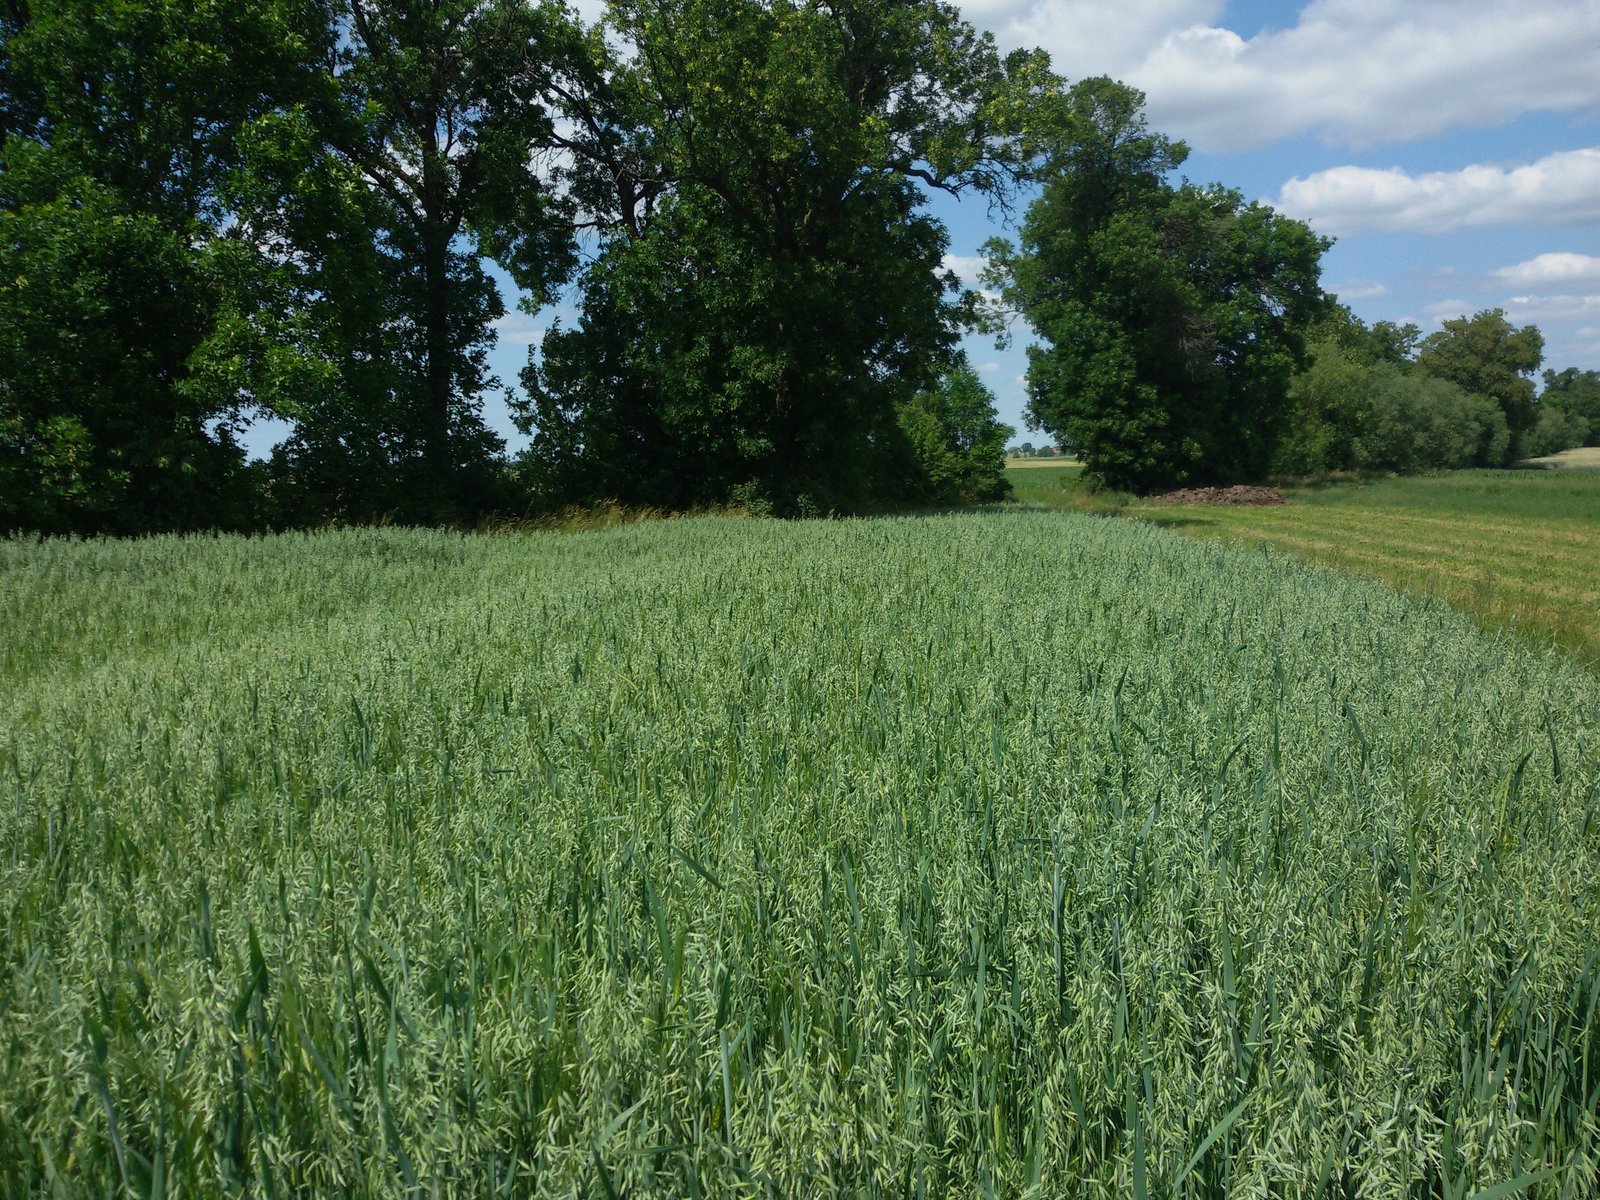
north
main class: Cropland
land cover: Barley
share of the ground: 50 - 75 %
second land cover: Oats
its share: 50 - 75 %
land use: Agriculture (excluding fallow land and kitchen gardens)
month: June
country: PL
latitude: 52.0021
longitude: 17.1044
